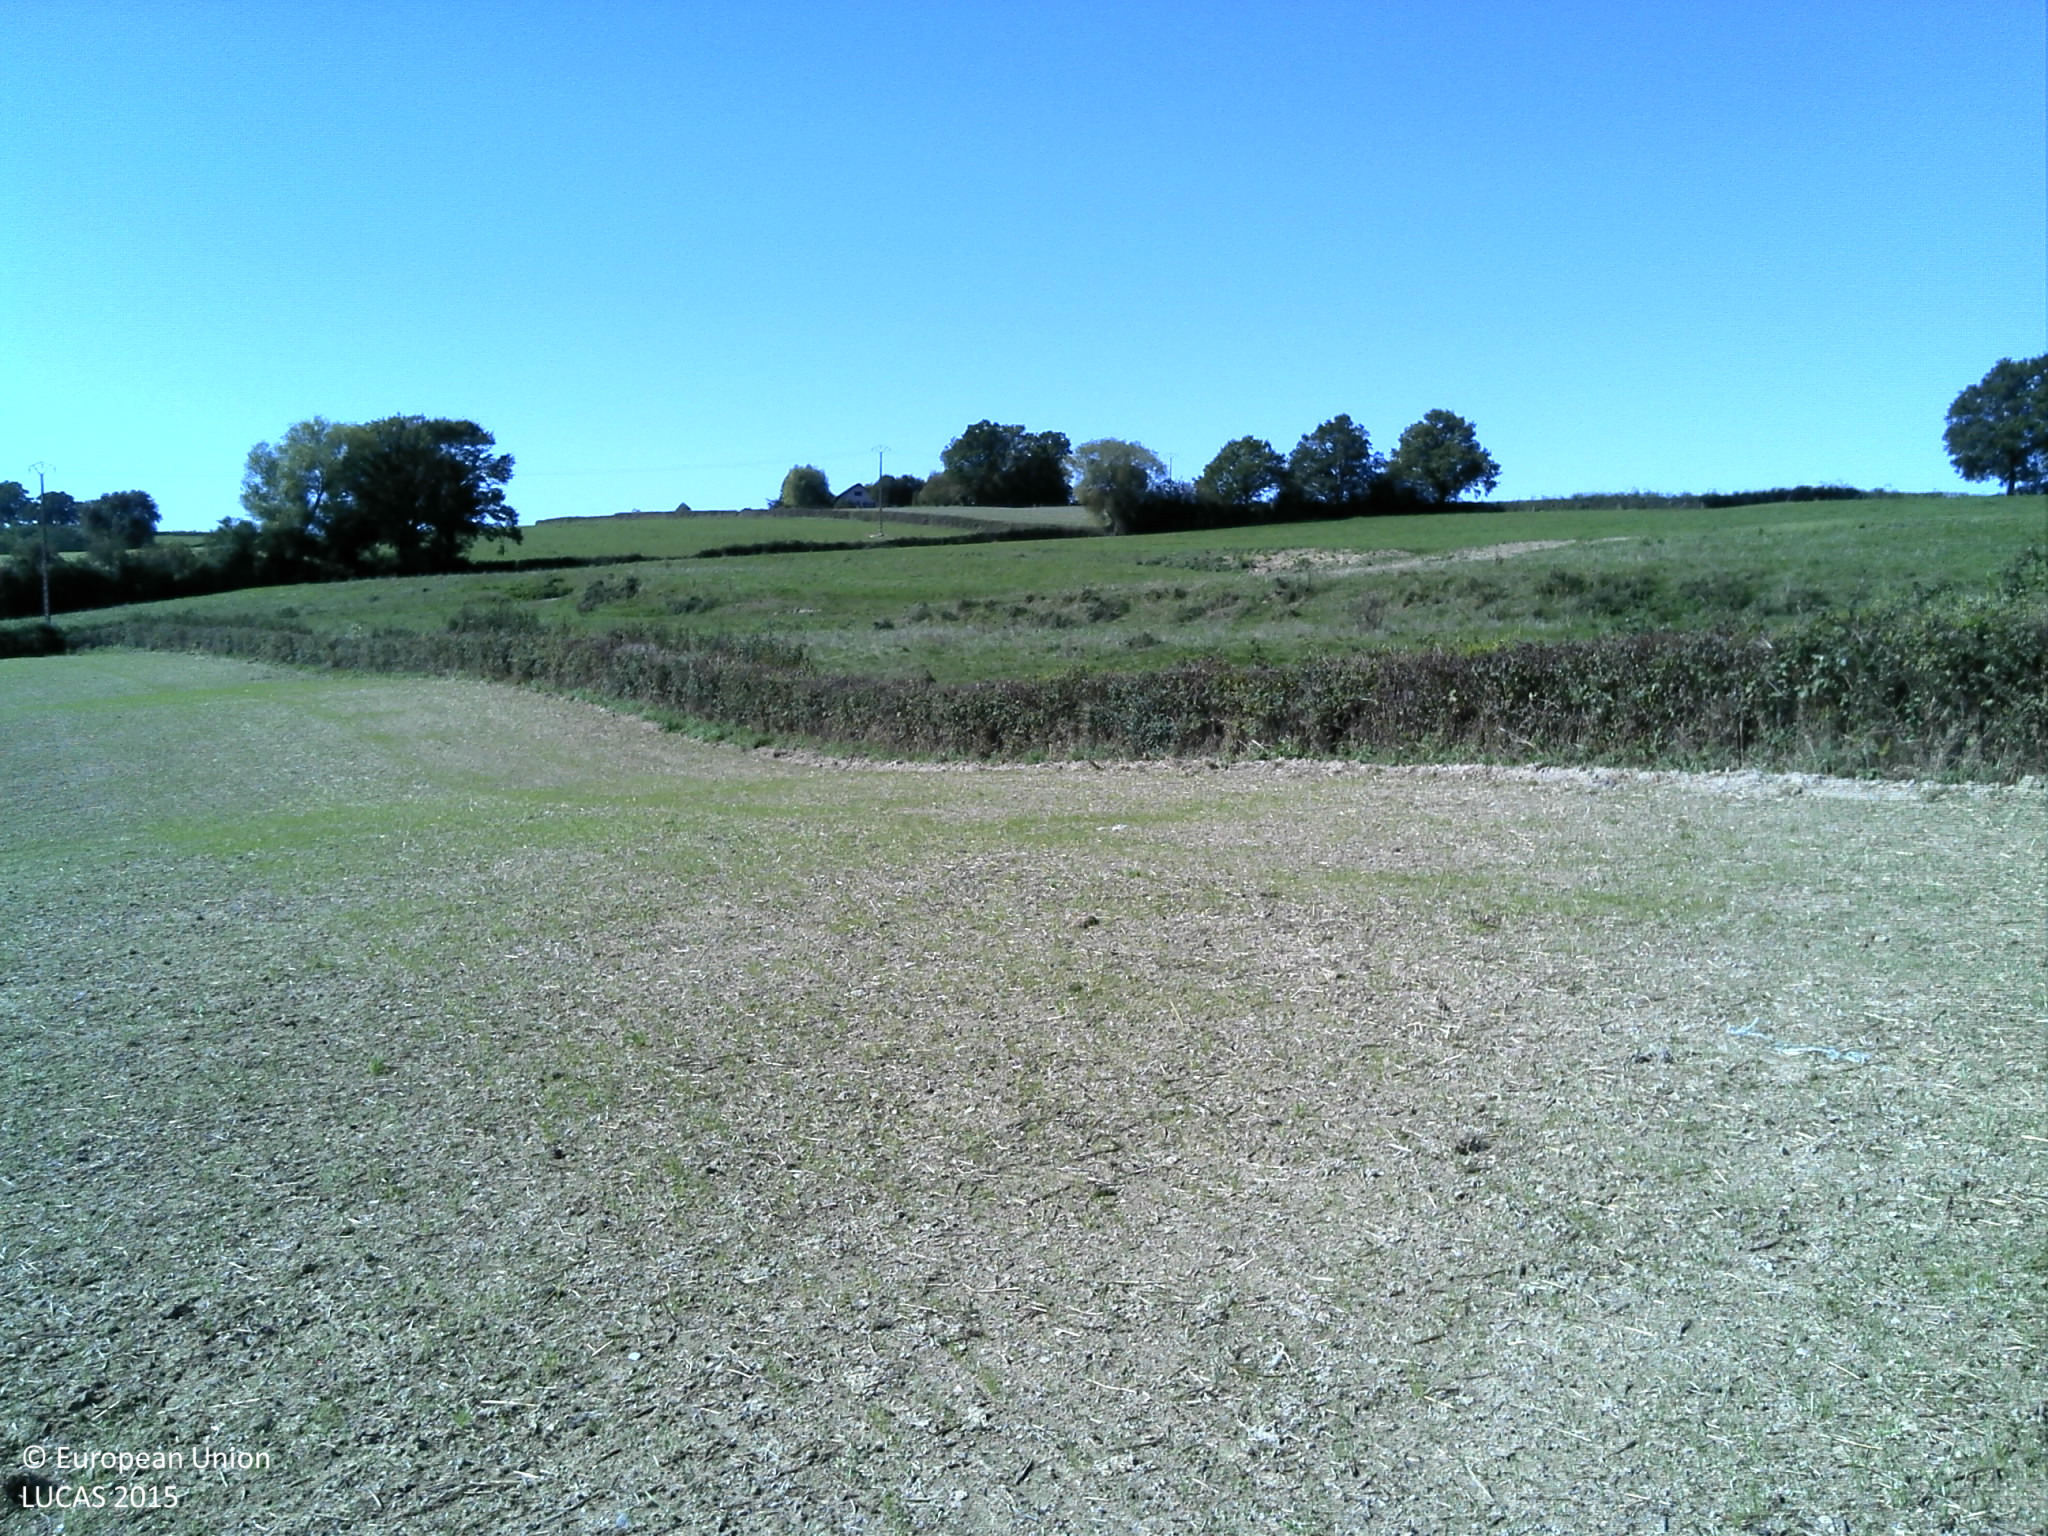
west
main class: Cropland
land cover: Common wheat
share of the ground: < 10 %
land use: Agriculture (excluding fallow land and kitchen gardens)
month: September
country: FR
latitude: 46.9786
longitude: 4.3603
